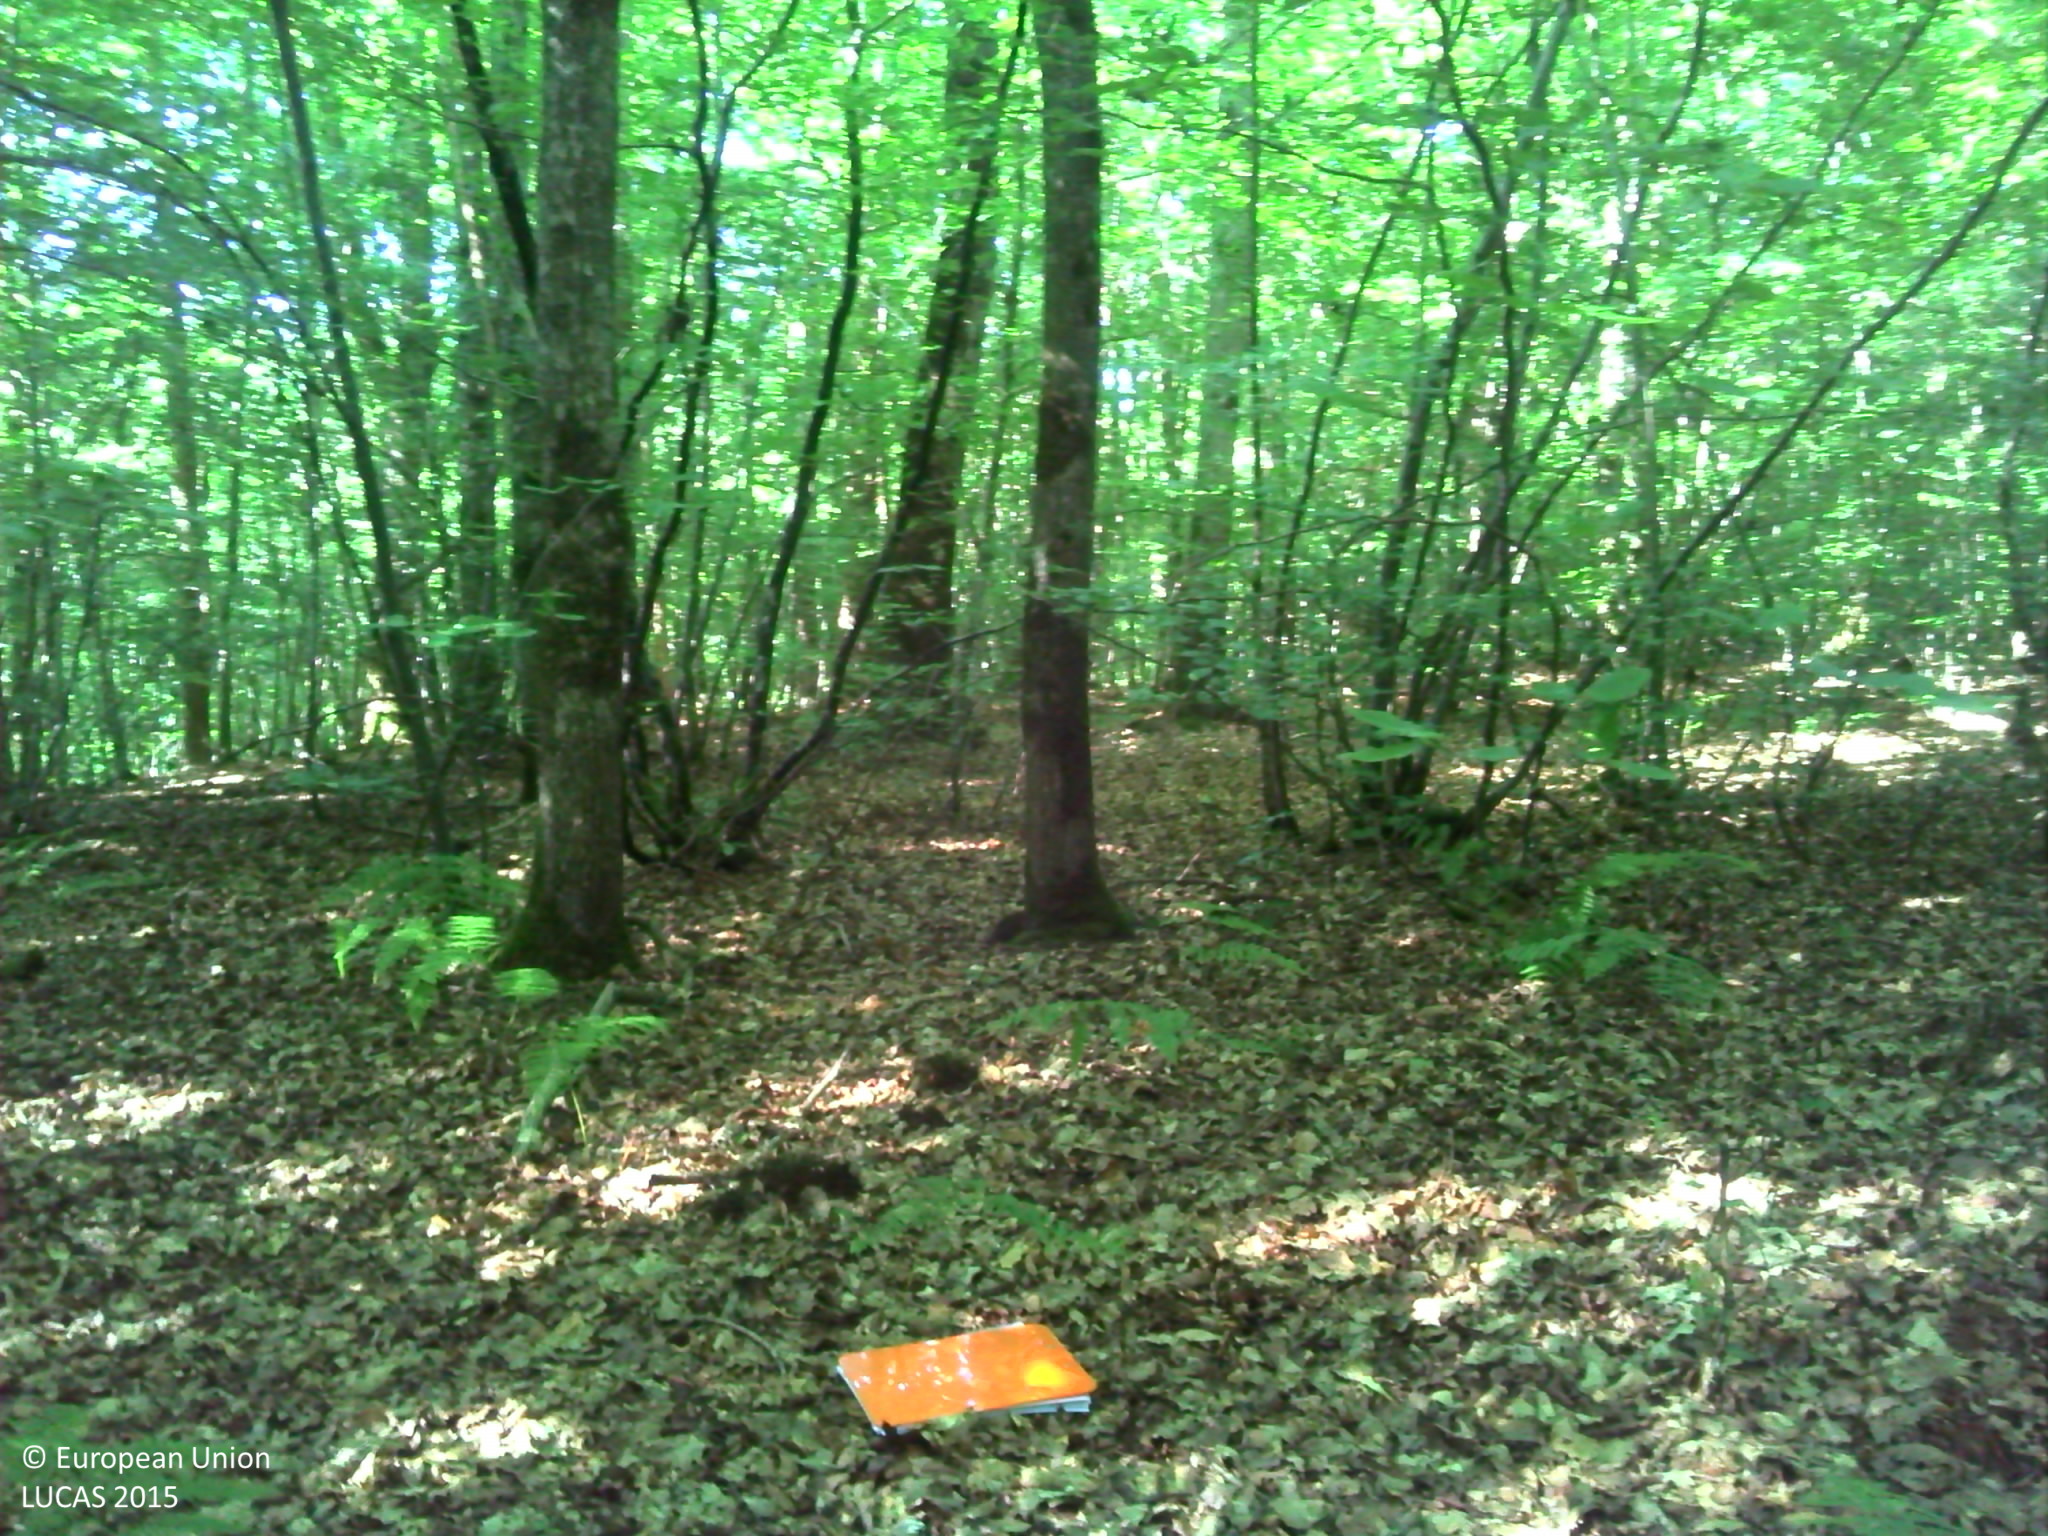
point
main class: Woodland
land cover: Broadleaved woodland
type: acidophilous oak and oak-birch forest
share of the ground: > 75 %
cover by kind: broadleaved forest trees 70 %, herbaceous plants 15 %, consolidated bare surface 15 %
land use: Forestry
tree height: > 5 m
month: July
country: FR
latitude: 49.0620
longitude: 0.7105
